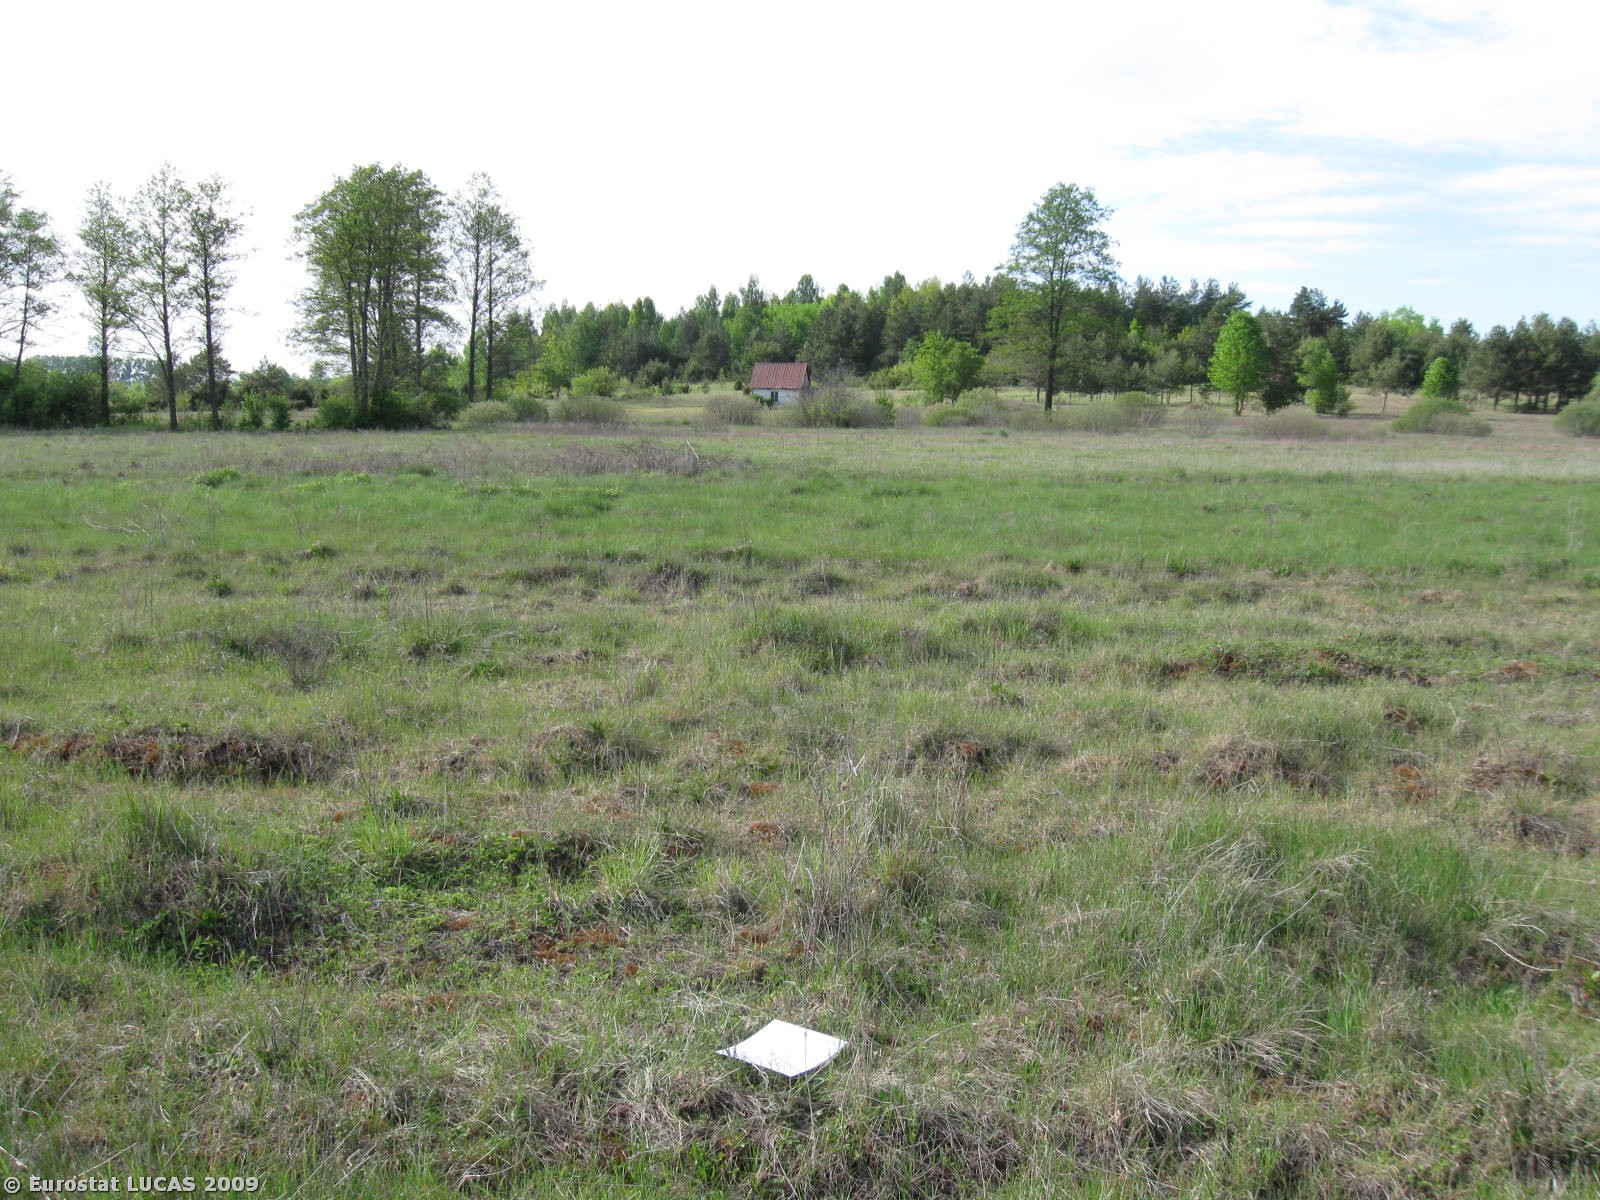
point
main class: Grassland
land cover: Grassland without tree/shrub cover
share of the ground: > 75 %
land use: Agriculture (excluding fallow land and kitchen gardens)
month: May
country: PL
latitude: 50.8504
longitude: 20.3917
